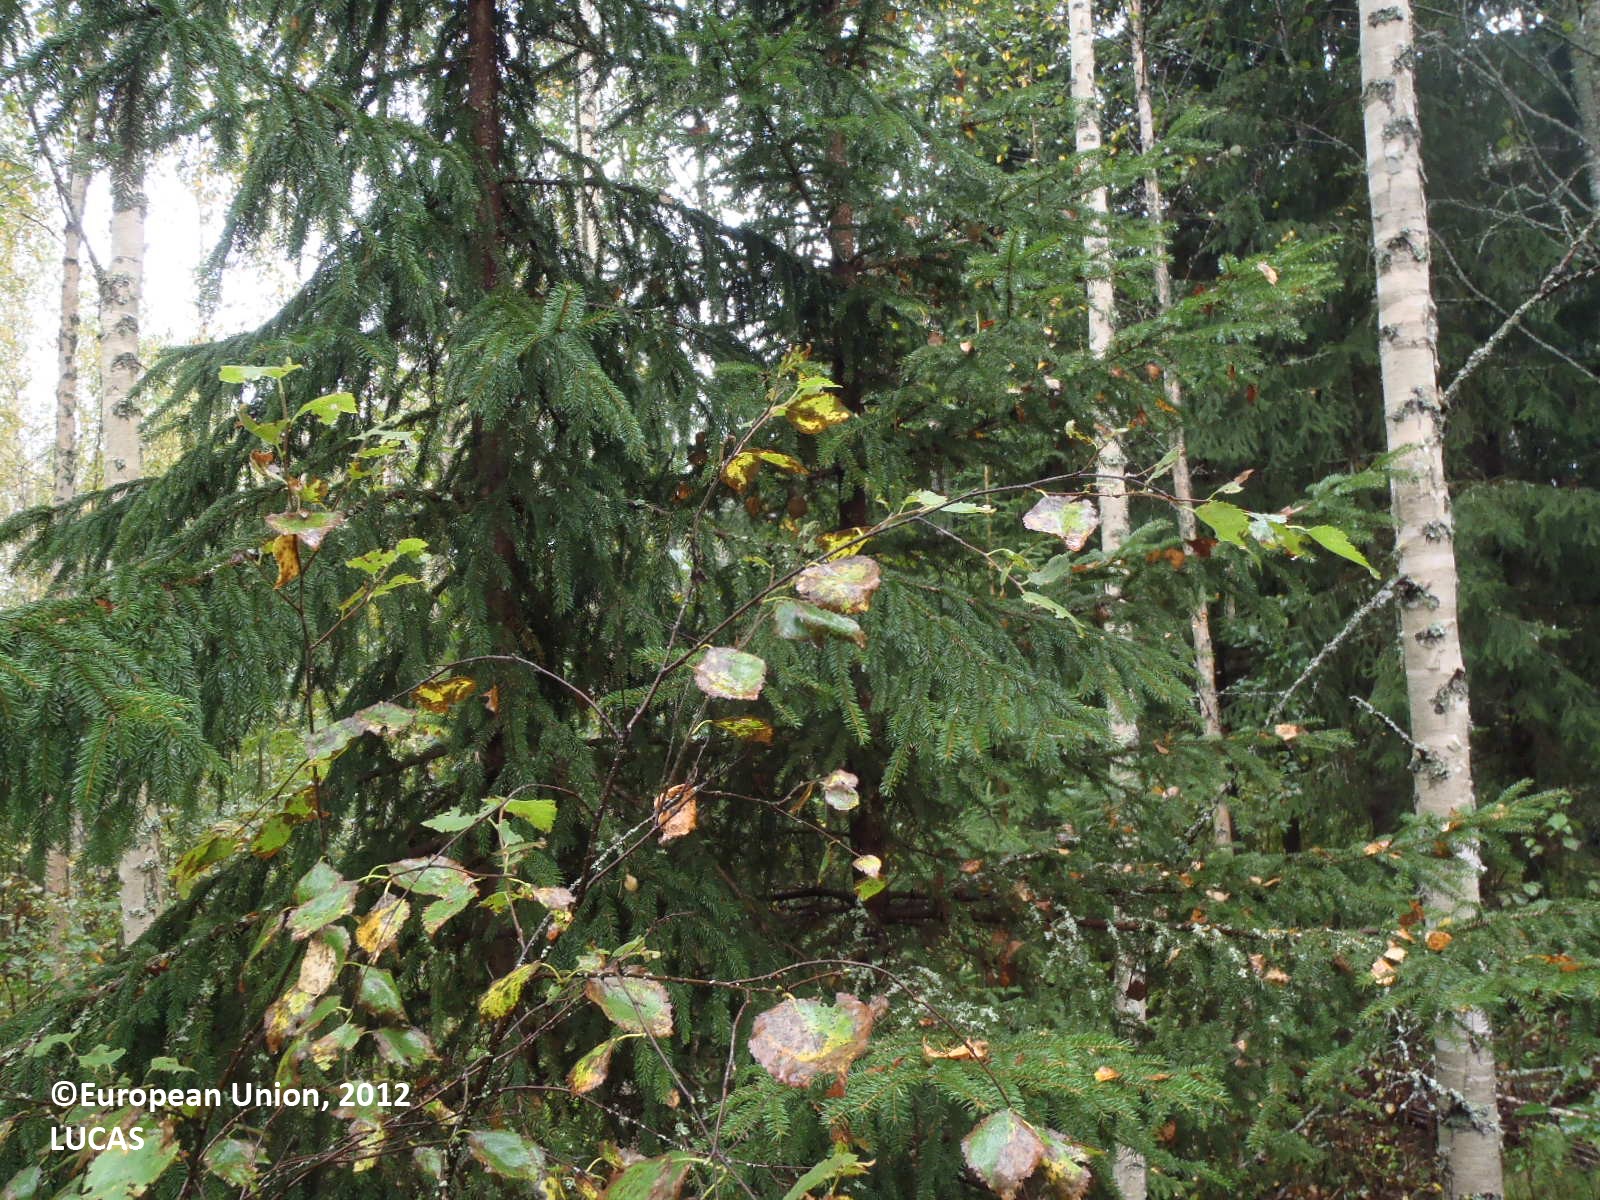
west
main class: Woodland
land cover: Broadleaved woodland
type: boreal forest
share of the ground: > 75 %
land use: Forestry
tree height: > 5 m
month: September
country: FI
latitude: 61.6049
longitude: 22.5995
